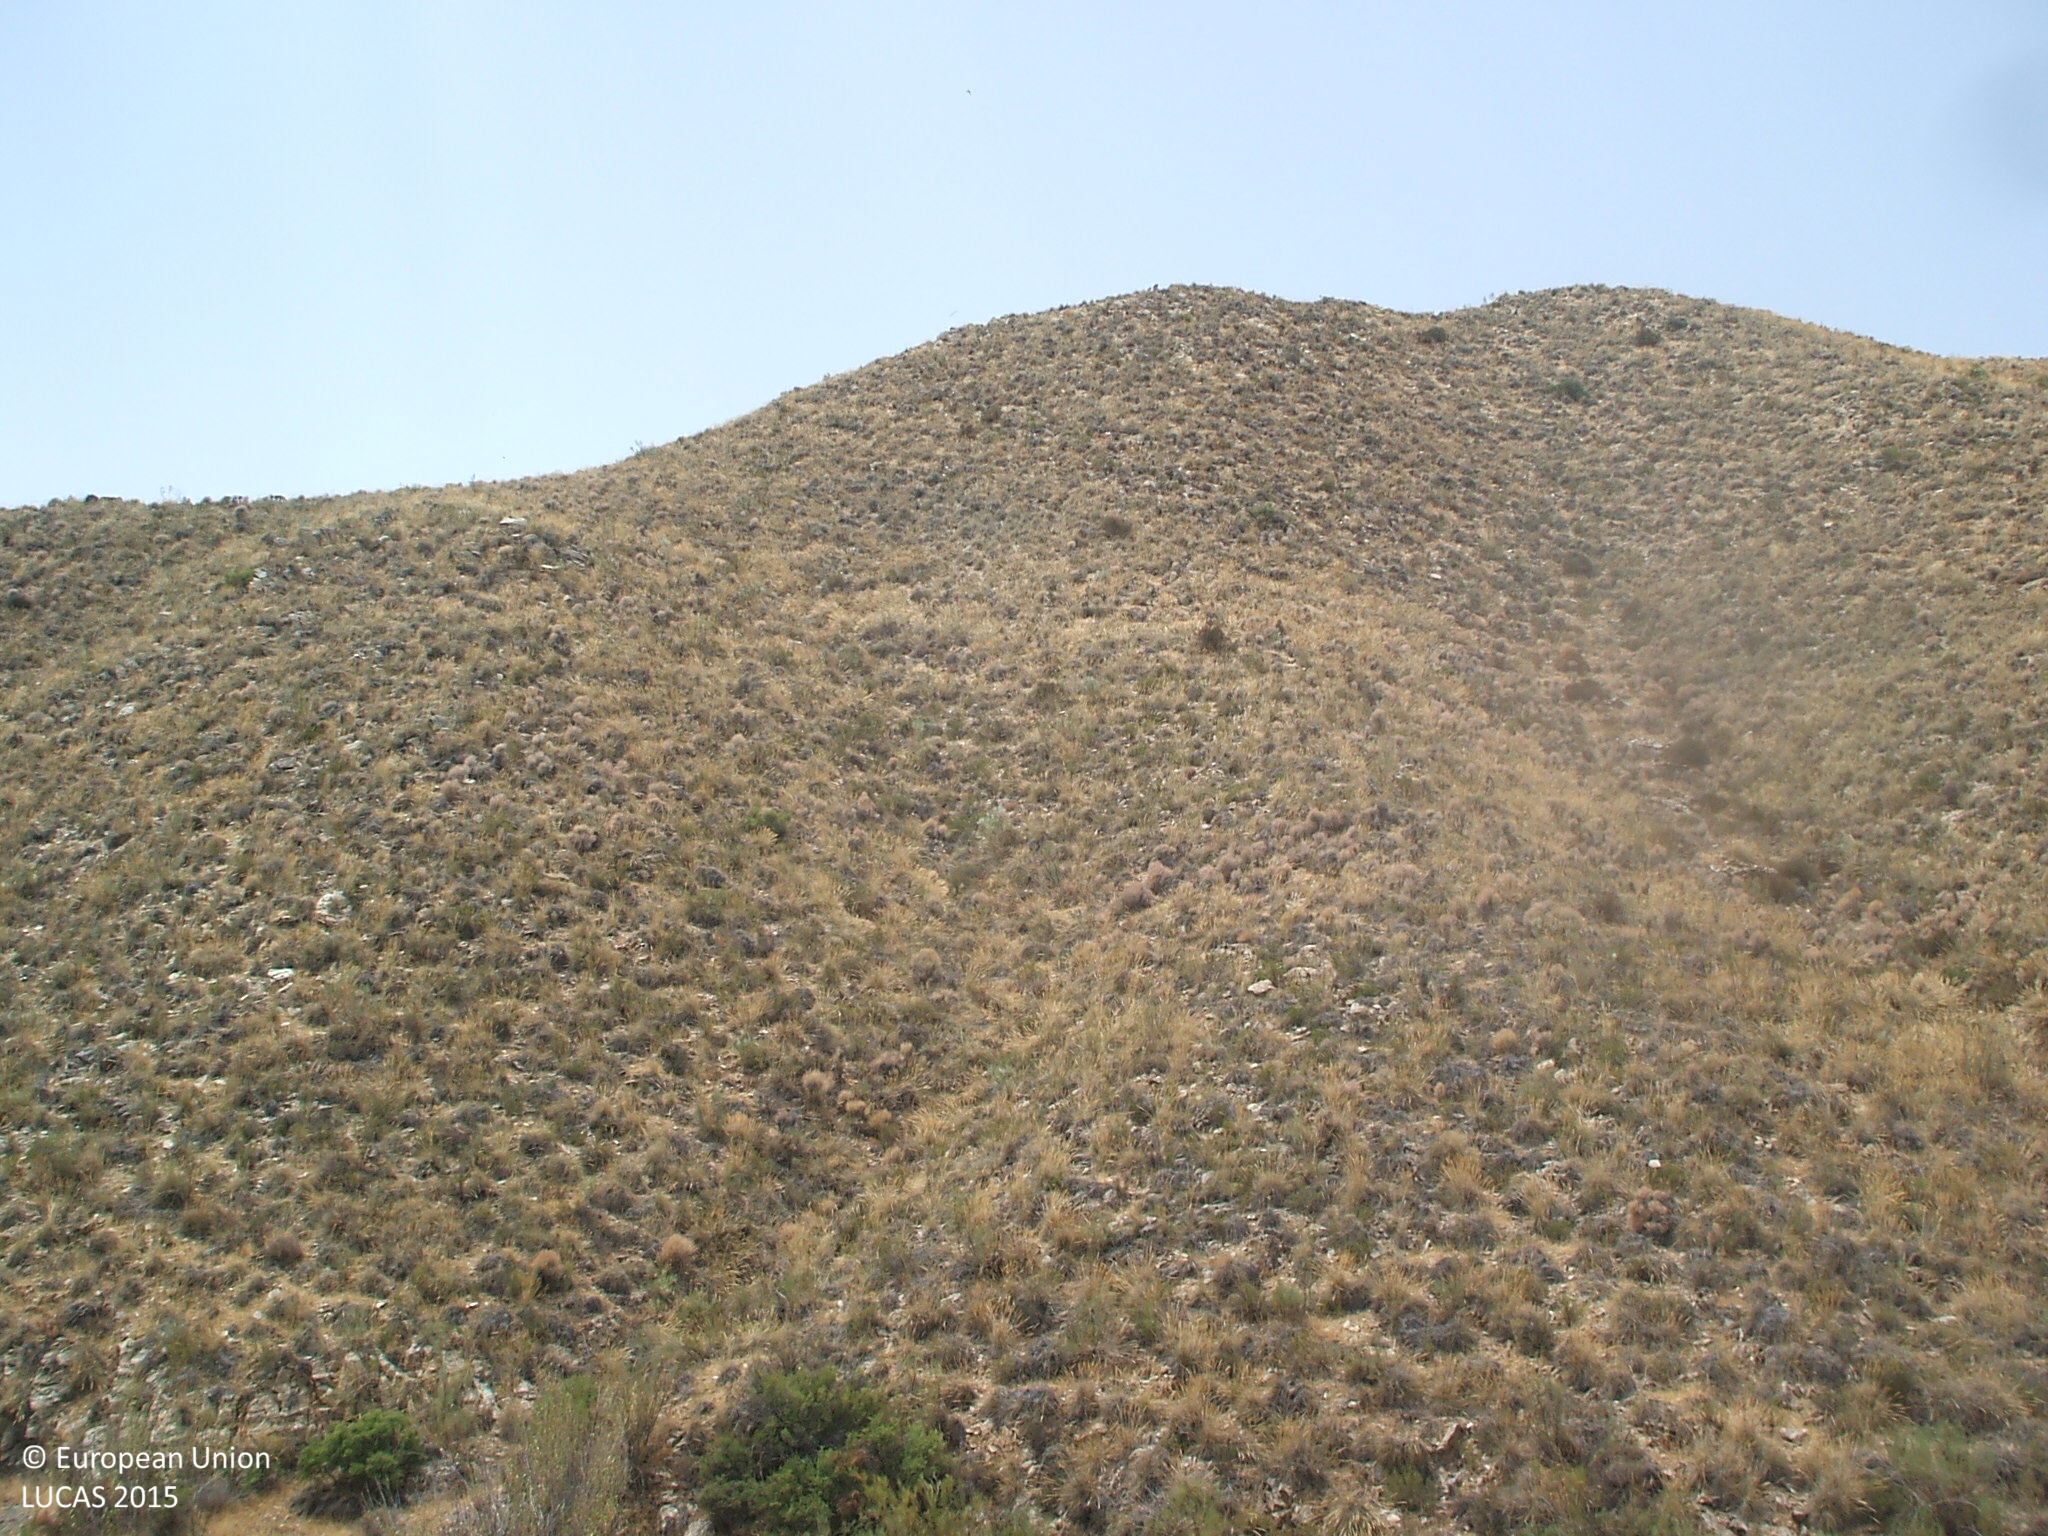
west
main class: Shrubland
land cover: Shrubland without tree cover
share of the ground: 50 - 75 %
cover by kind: shrubs 60 %, consolidated bare surface 40 %
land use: Semi-natural and natural areas not in use
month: July
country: ES
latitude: 37.1701
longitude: -2.2659
